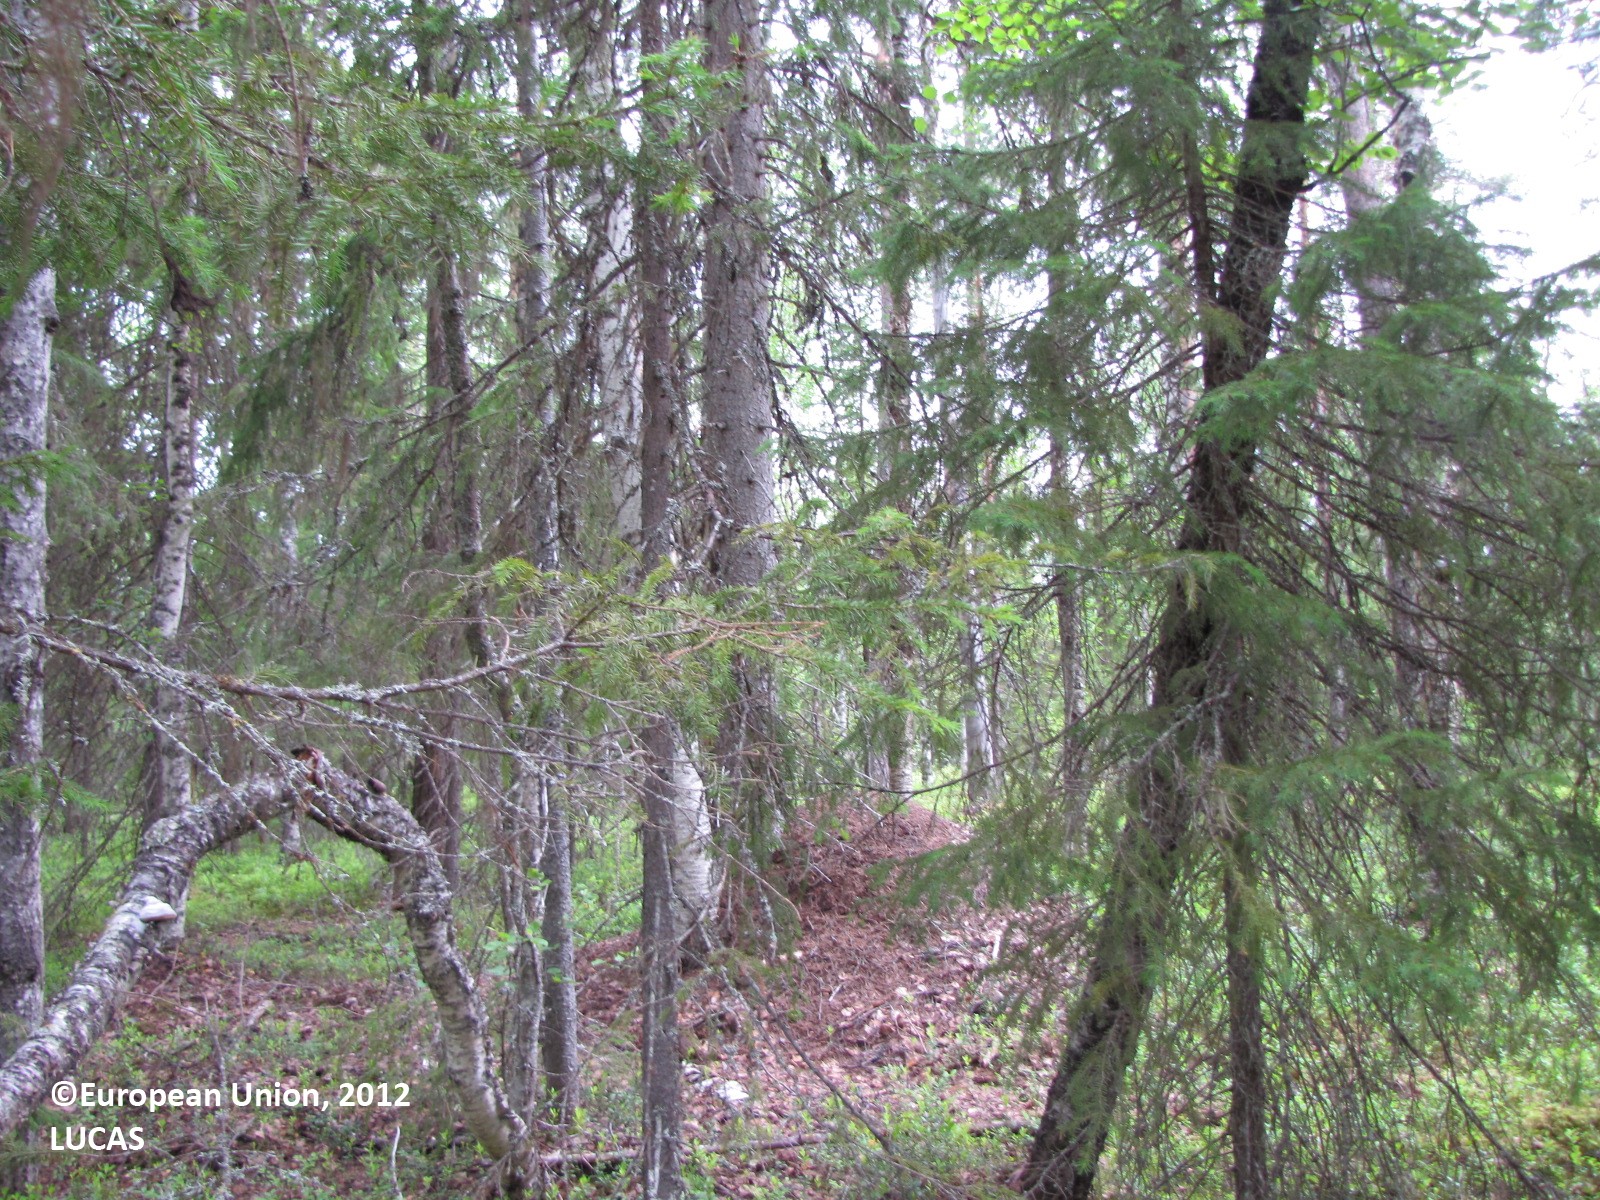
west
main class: Woodland
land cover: Spruce dominated mixed woodland
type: boreal forest
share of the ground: 50 - 75 %
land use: Forestry
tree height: > 5 m
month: July
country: FI
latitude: 66.6380
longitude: 24.9897
